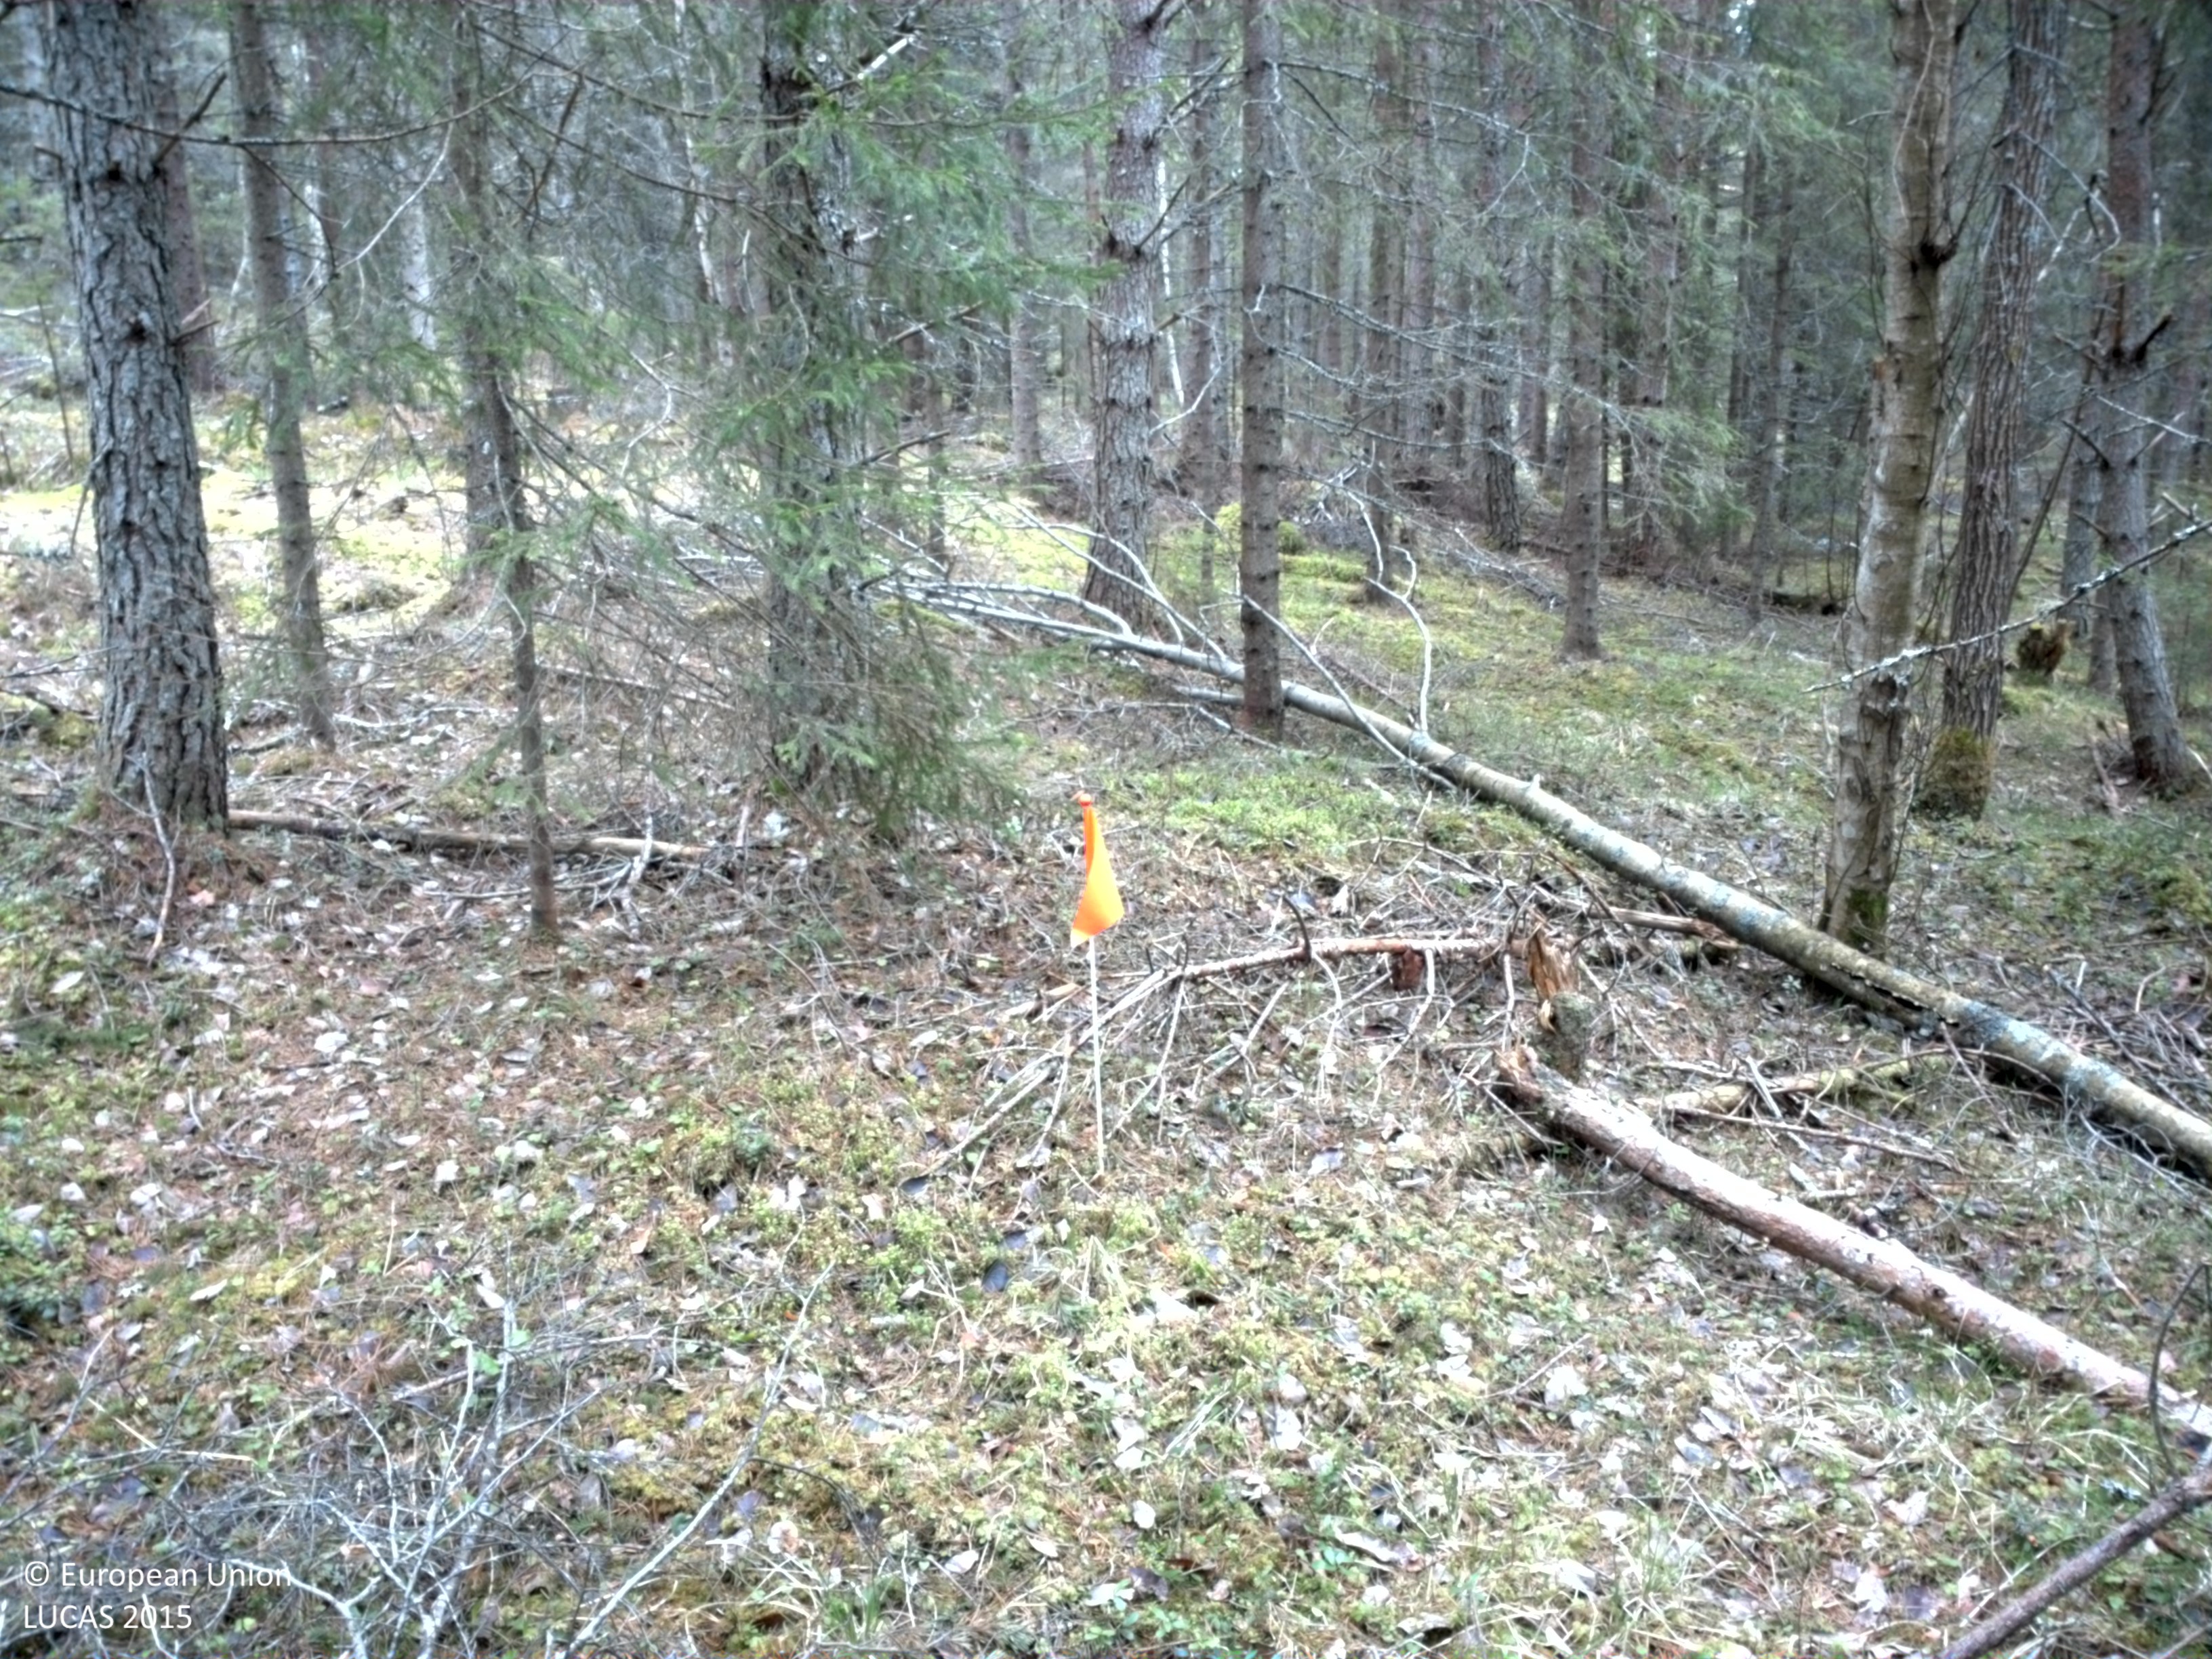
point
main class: Woodland
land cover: Pine dominated mixed woodland
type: boreal forest
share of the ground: > 75 %
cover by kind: coniferous forest trees 60 %, broadleaved forest trees 20 %, lichens and mosses 10 %, shrubs 5 %, herbaceous plants 5 %
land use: Forestry
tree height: > 5 m
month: June
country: SE
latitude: 63.4819
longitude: 13.9347
